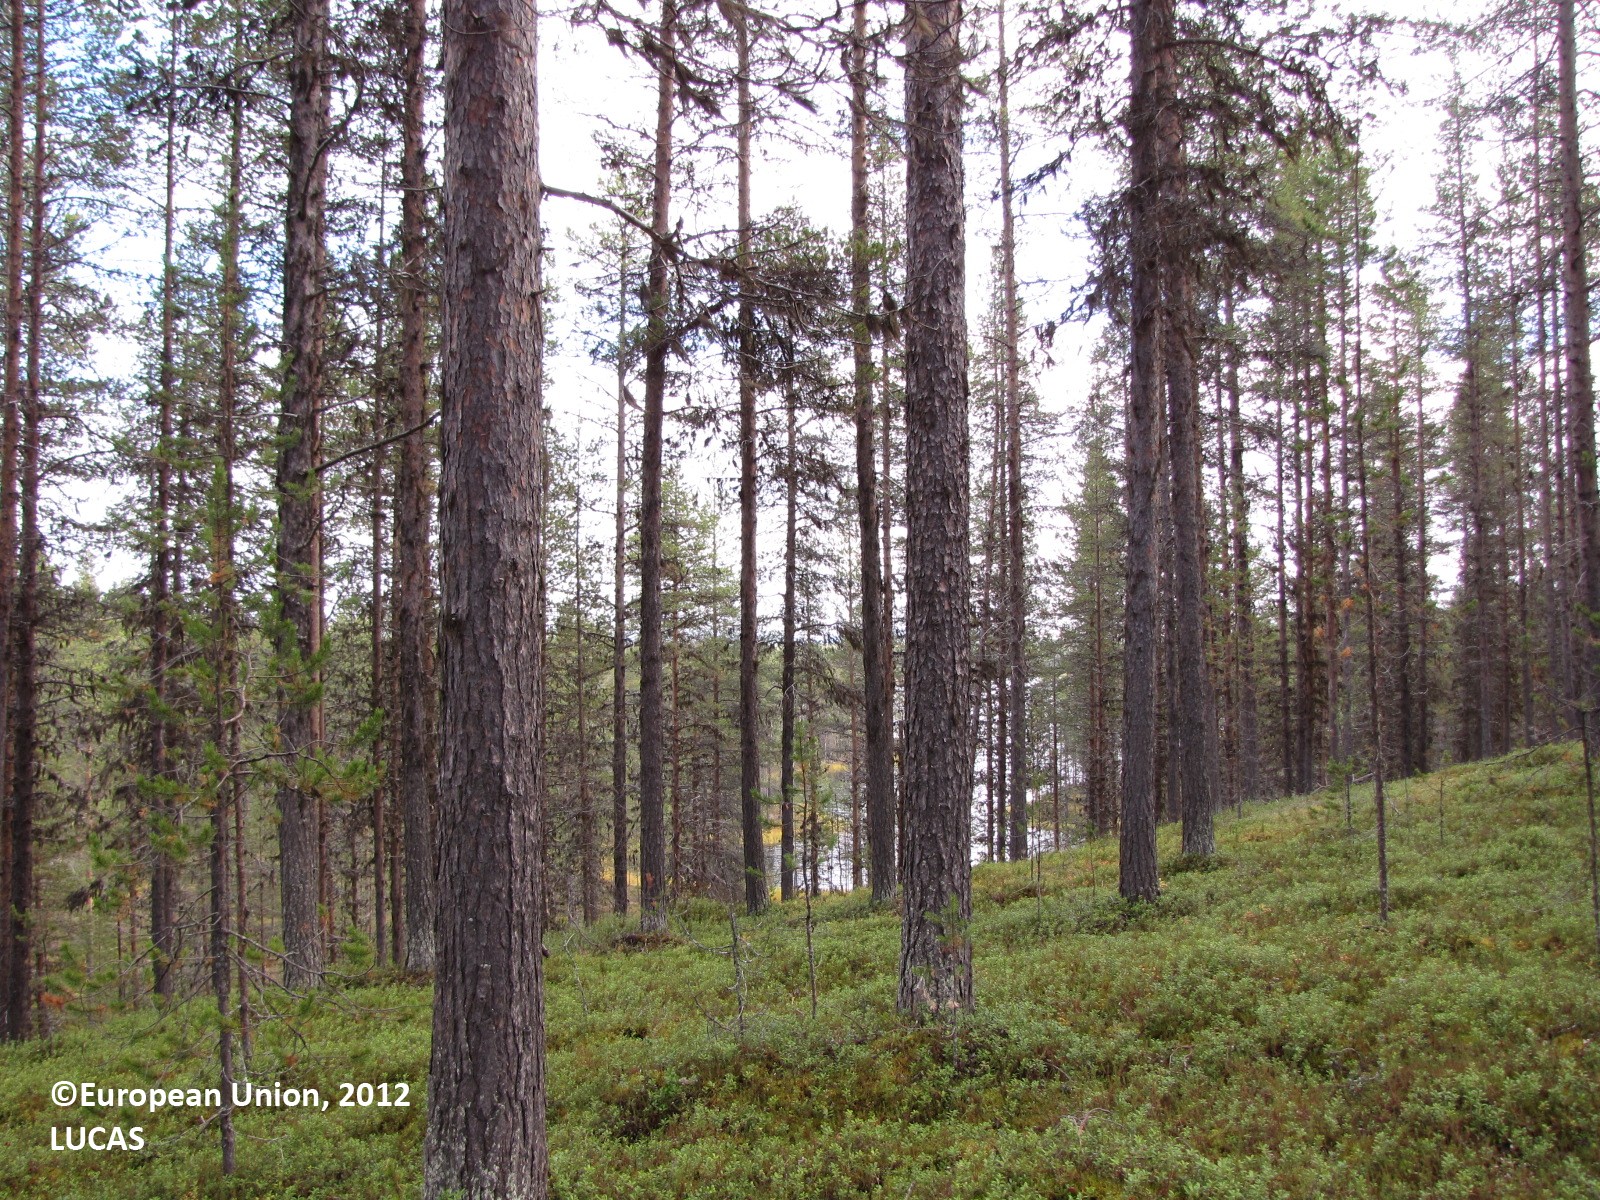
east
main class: Woodland
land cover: Pine dominated coniferous woodland
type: boreal forest
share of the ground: 25 - 50 %
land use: Forestry
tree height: > 5 m
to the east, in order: Pine dominated coniferous woodland; Tracks; Pine dominated coniferous woodland; Grassland without tree/shrub cover; Inland water bodies; Grassland without tree/shrub cover; Pine dominated coniferous woodland; Grassland without tree/shrub cover; Inland water bodies; Grassland without tree/shrub cover; Pine dominated coniferous woodland; Grassland without tree/shrub cover; Inland water bodies; Grassland without tree/shrub cover; Pine dominated coniferous woodland
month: September
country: FI
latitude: 67.8669
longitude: 23.5448
